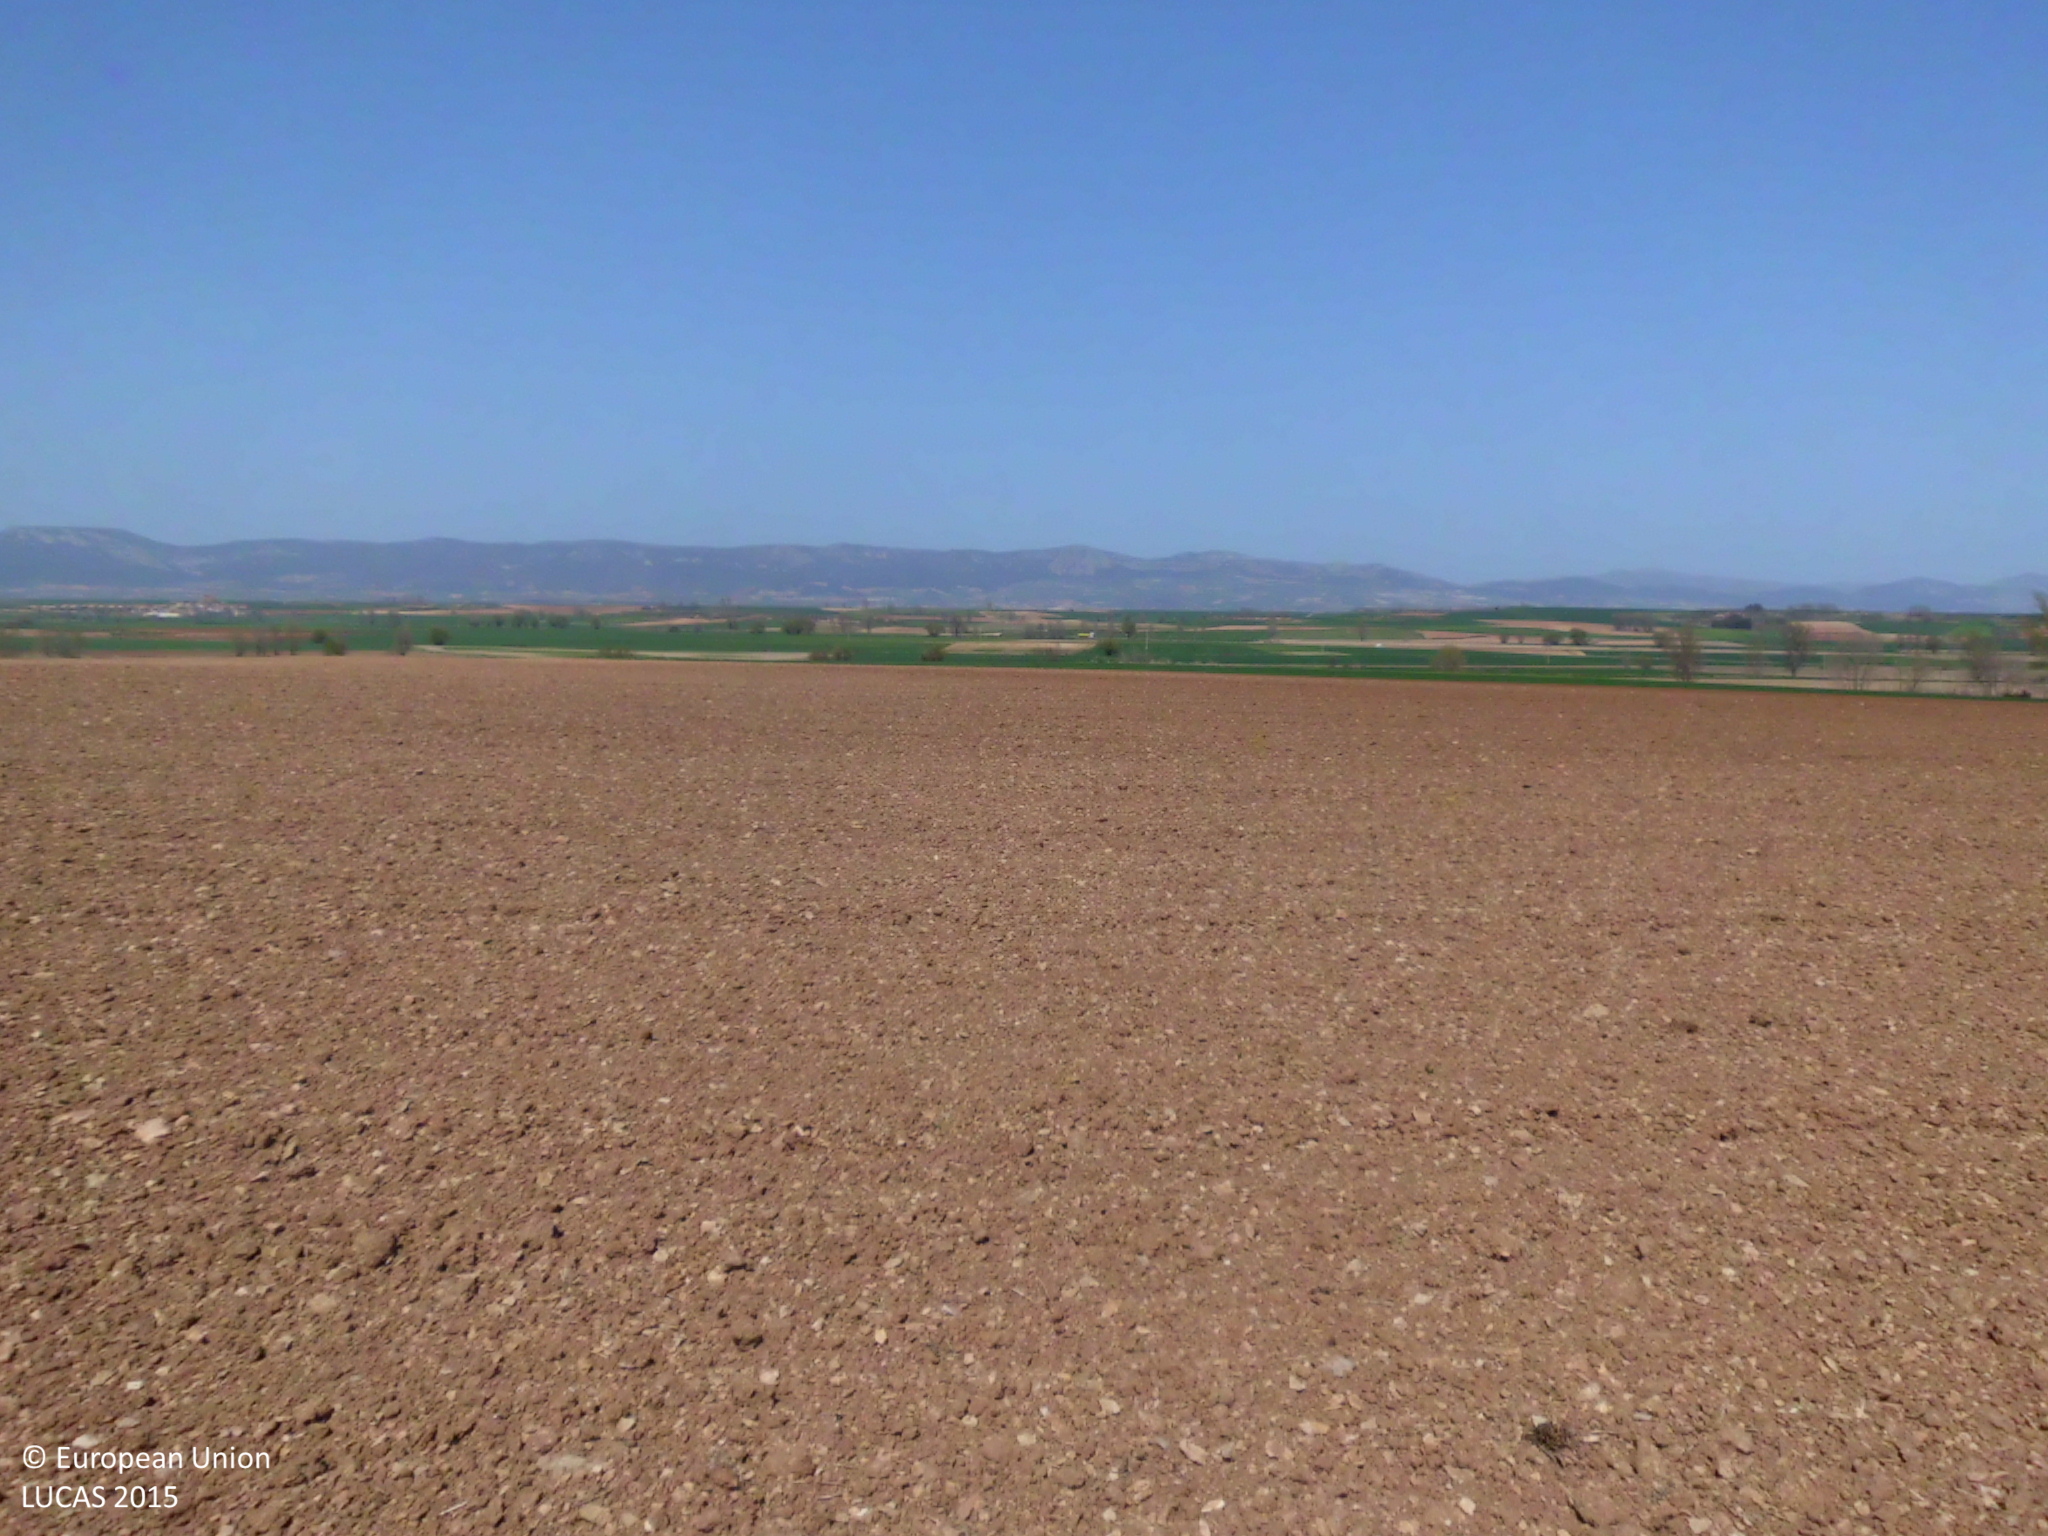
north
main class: Cropland
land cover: Dry pulses
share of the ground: < 10 %
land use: Agriculture (excluding fallow land and kitchen gardens)
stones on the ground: < 10 %
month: April
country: ES
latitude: 42.5880
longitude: -3.3525
